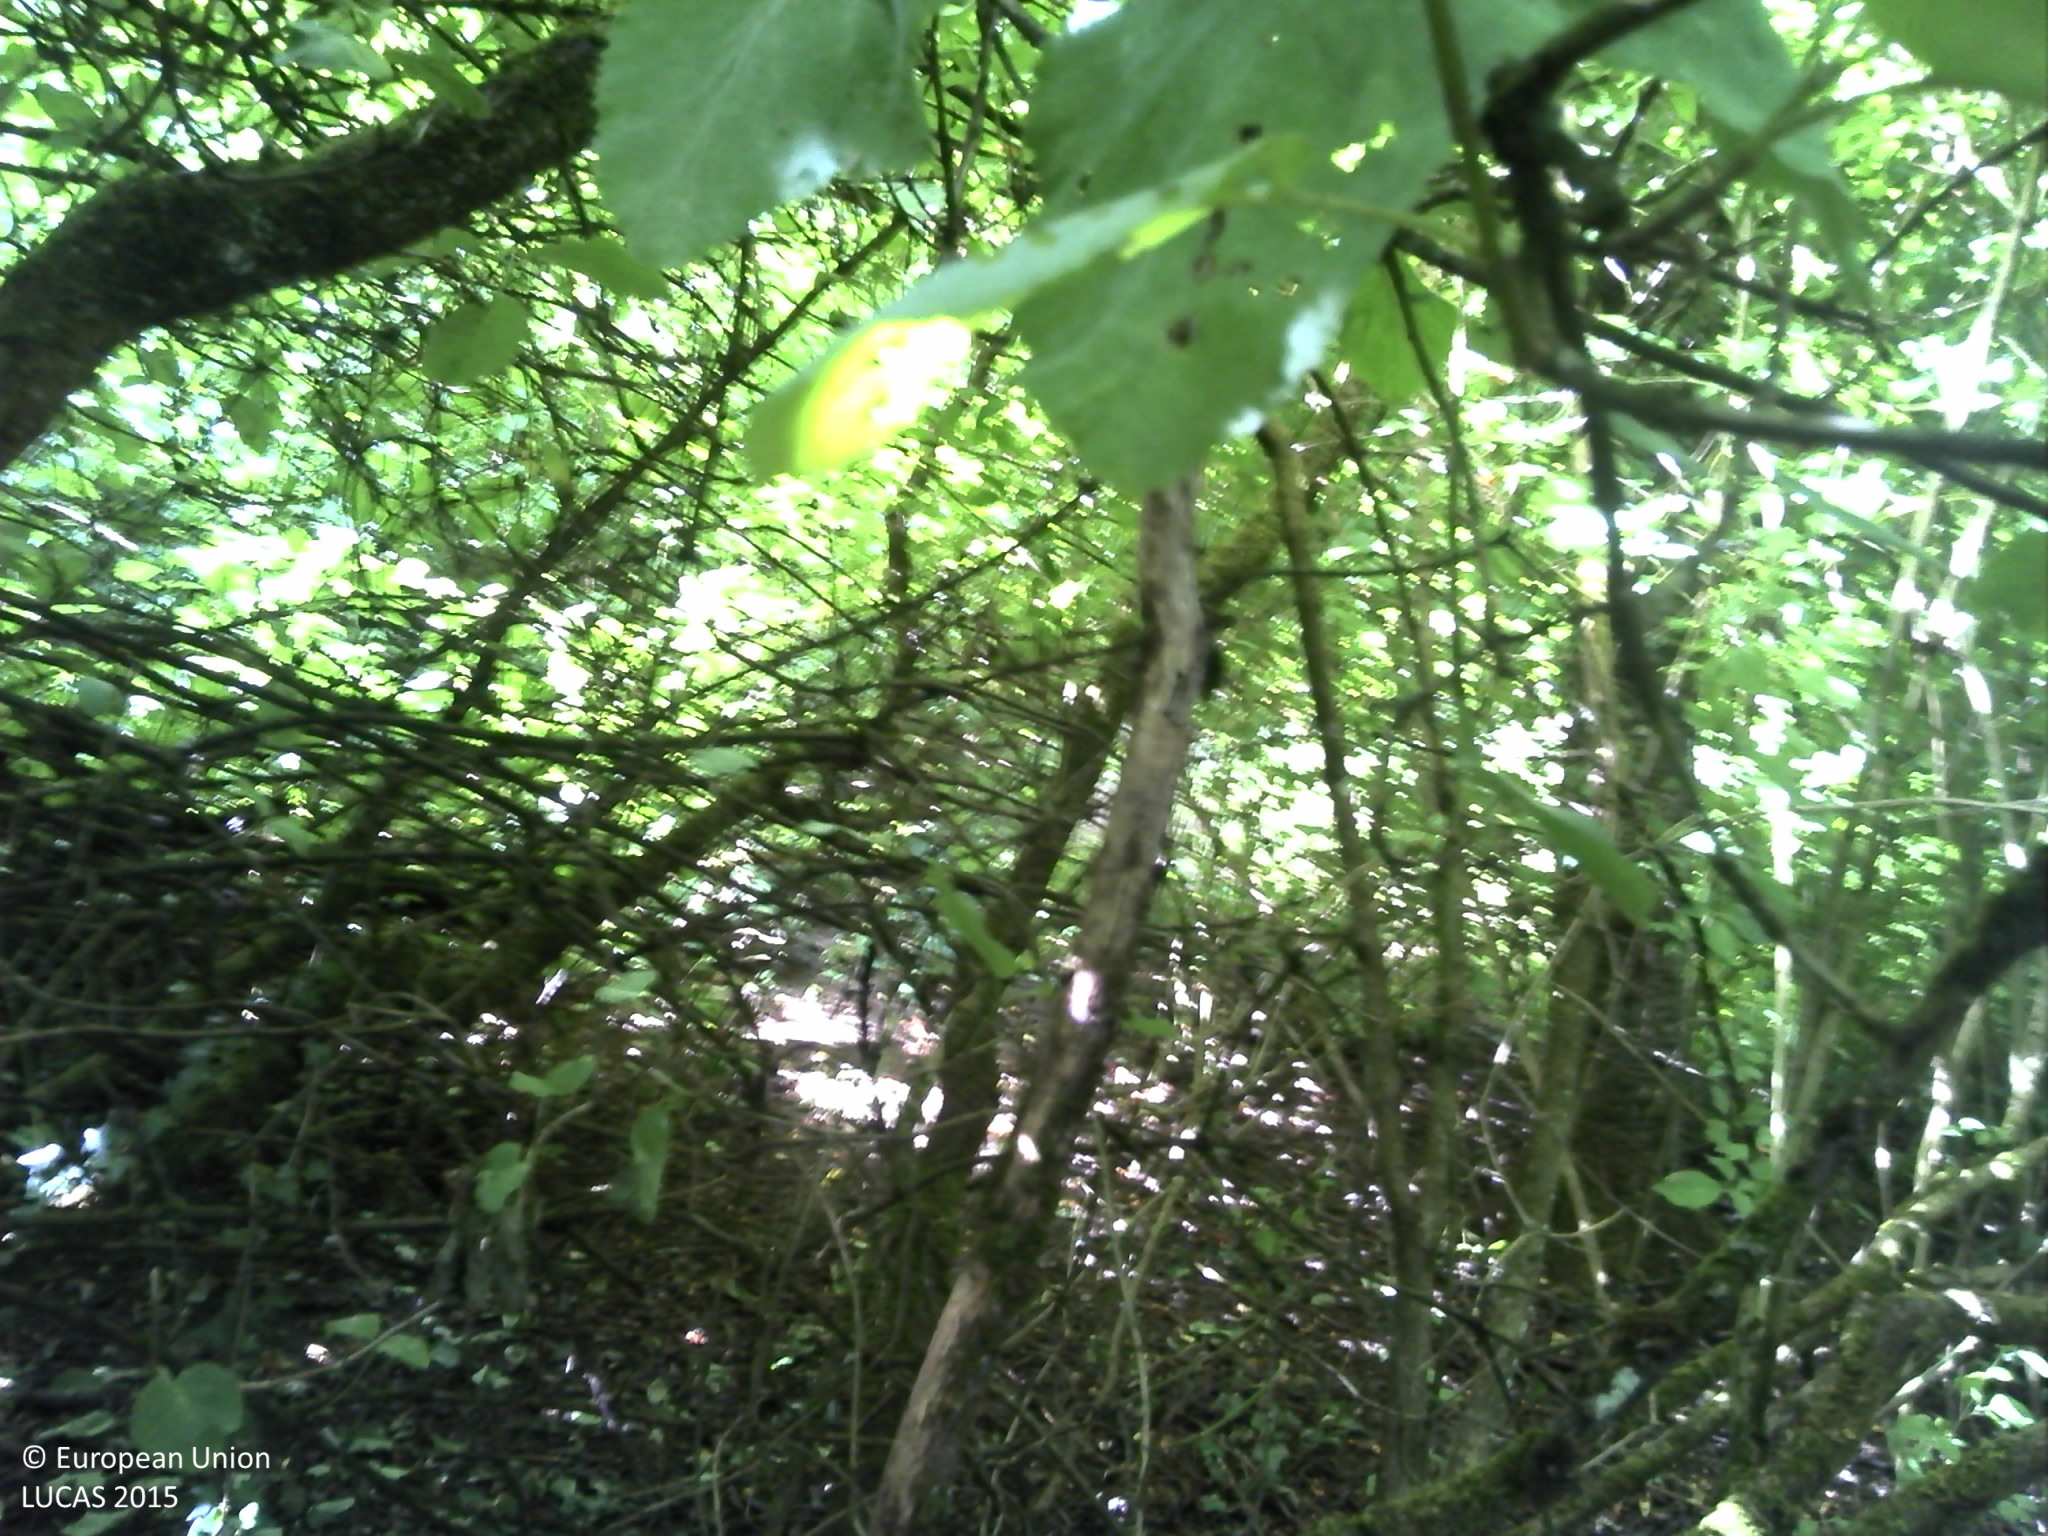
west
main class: Woodland
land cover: Broadleaved woodland
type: non-riverine alder, birch or aspen forest
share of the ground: > 75 %
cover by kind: broadleaved forest trees 90 %, shrubs 10 %
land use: Semi-natural and natural areas not in use
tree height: > 5 m
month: June
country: FR
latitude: 49.2527
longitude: 6.0840
